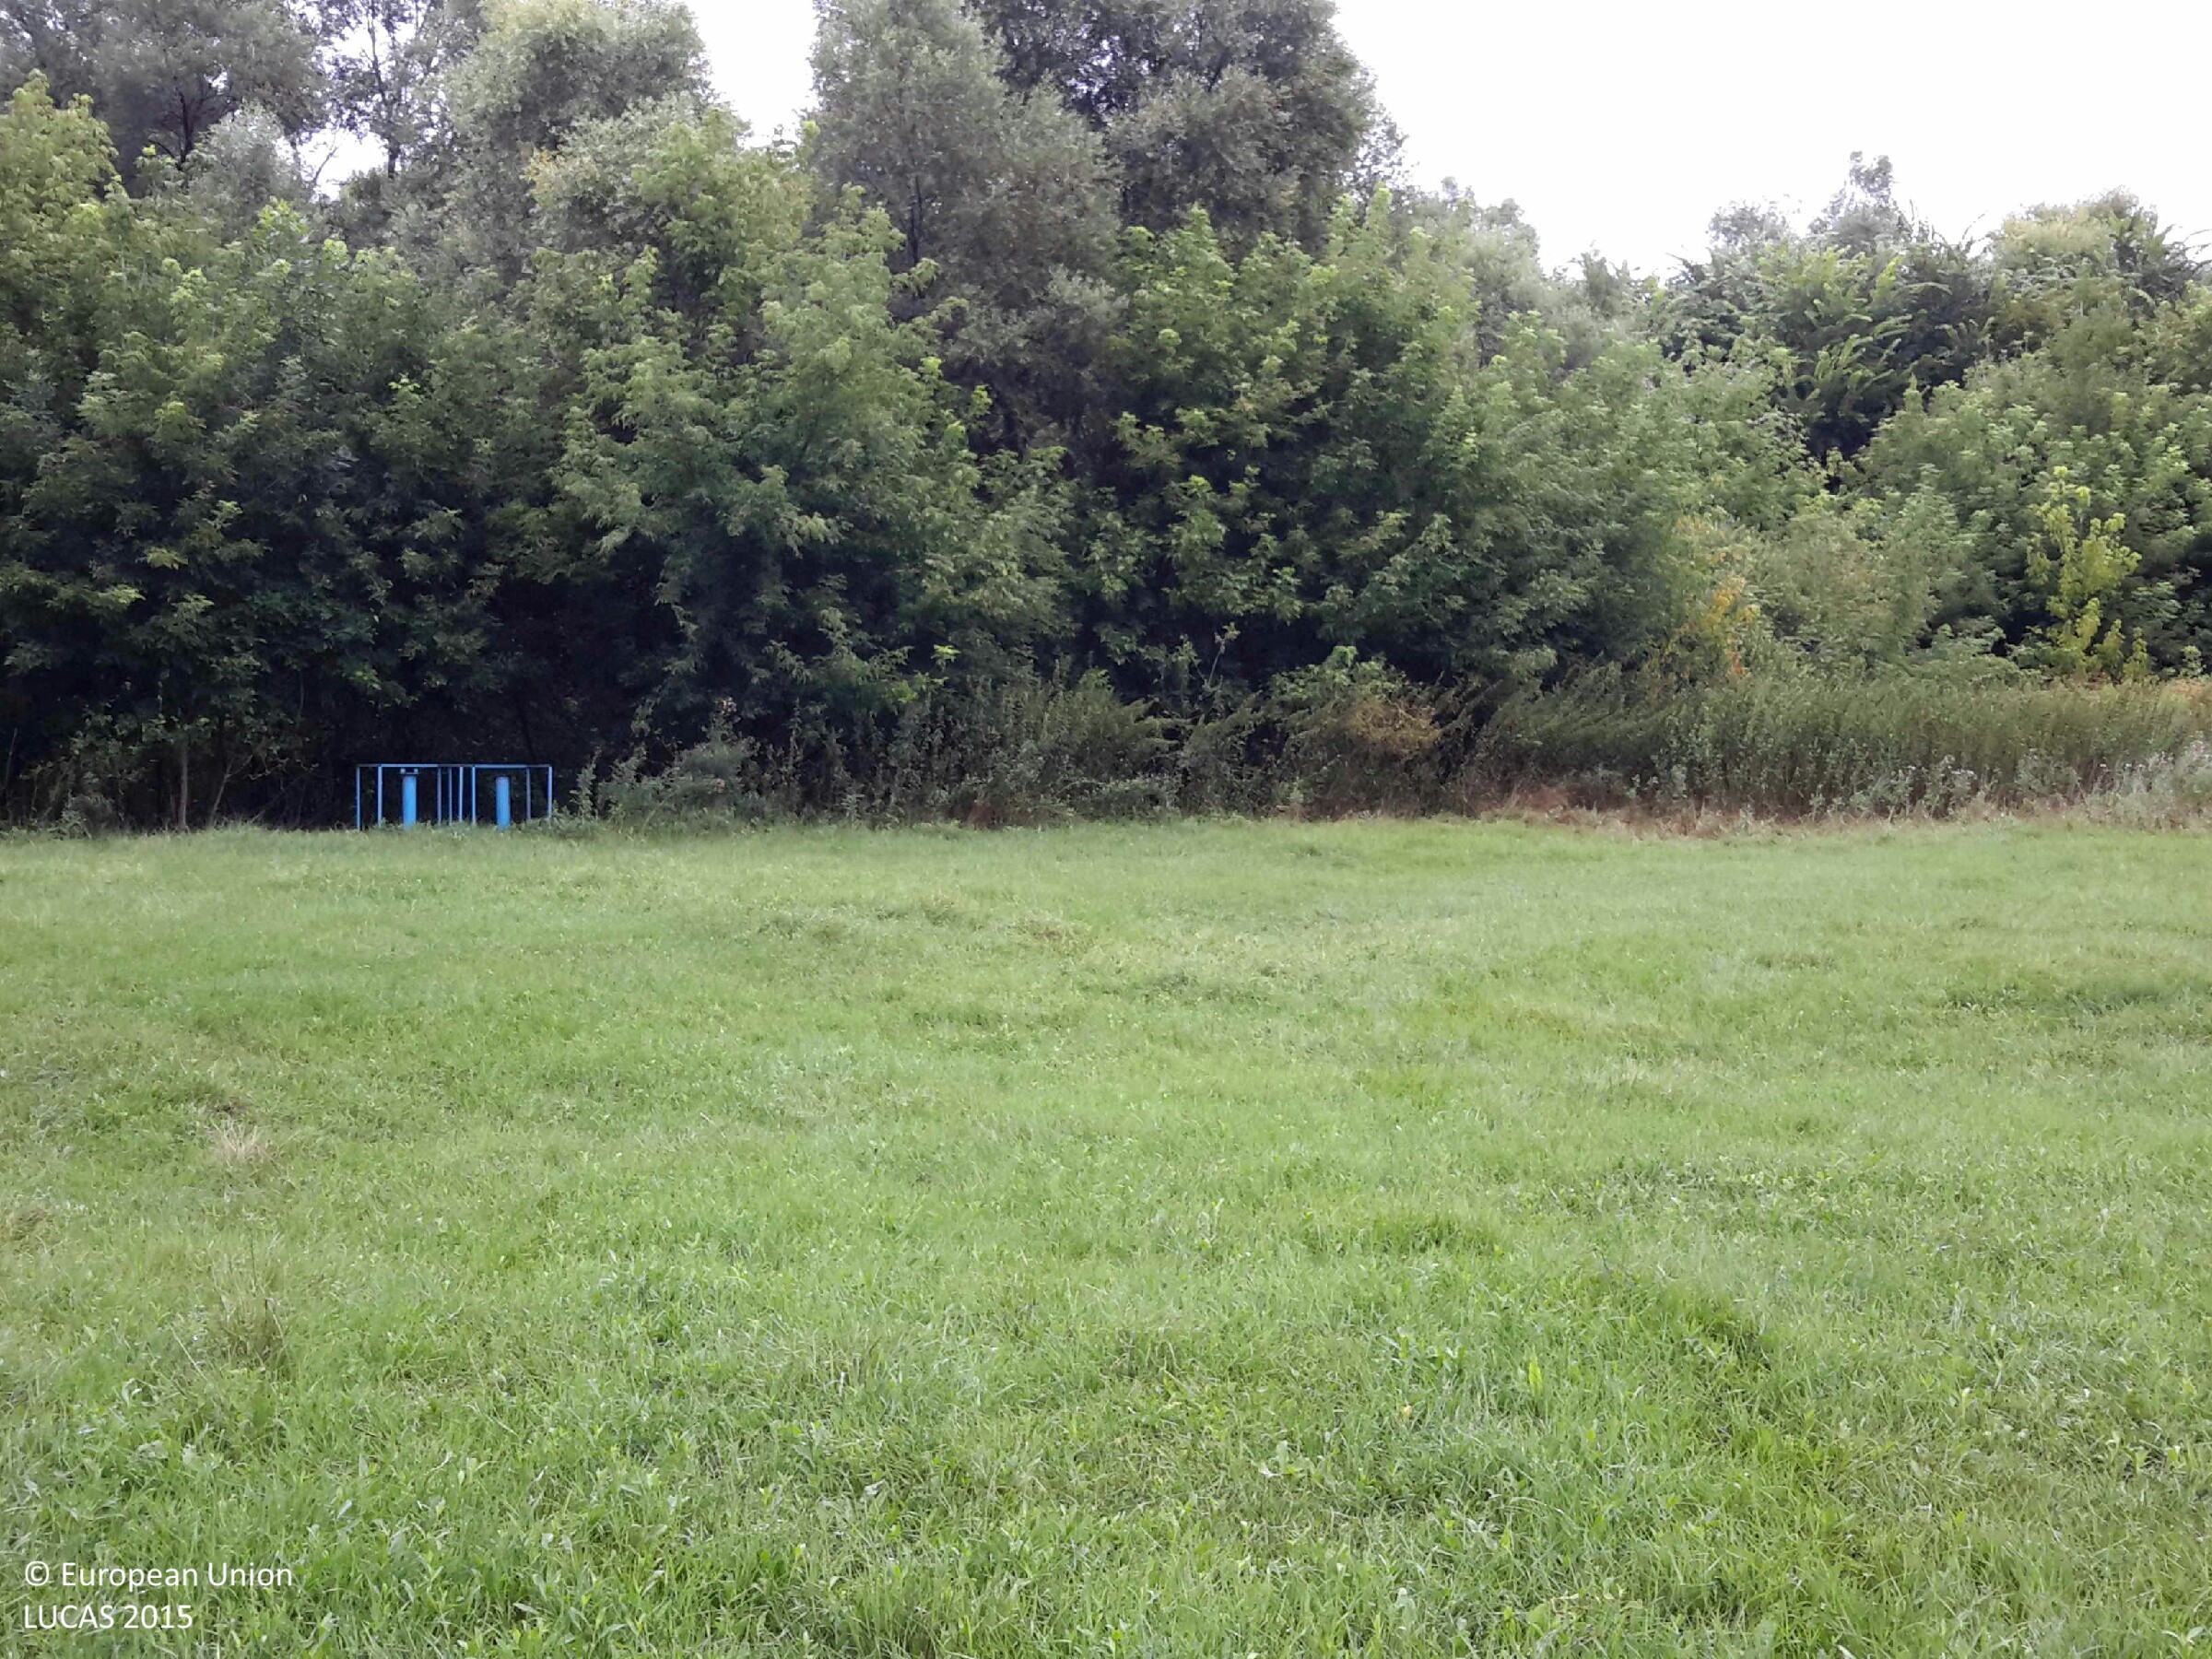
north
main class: Grassland
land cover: Grassland without tree/shrub cover
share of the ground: > 75 %
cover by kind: herbaceous plants 100 %
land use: Agriculture (excluding fallow land and kitchen gardens)
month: July
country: HU
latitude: 47.6245
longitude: 17.5000
